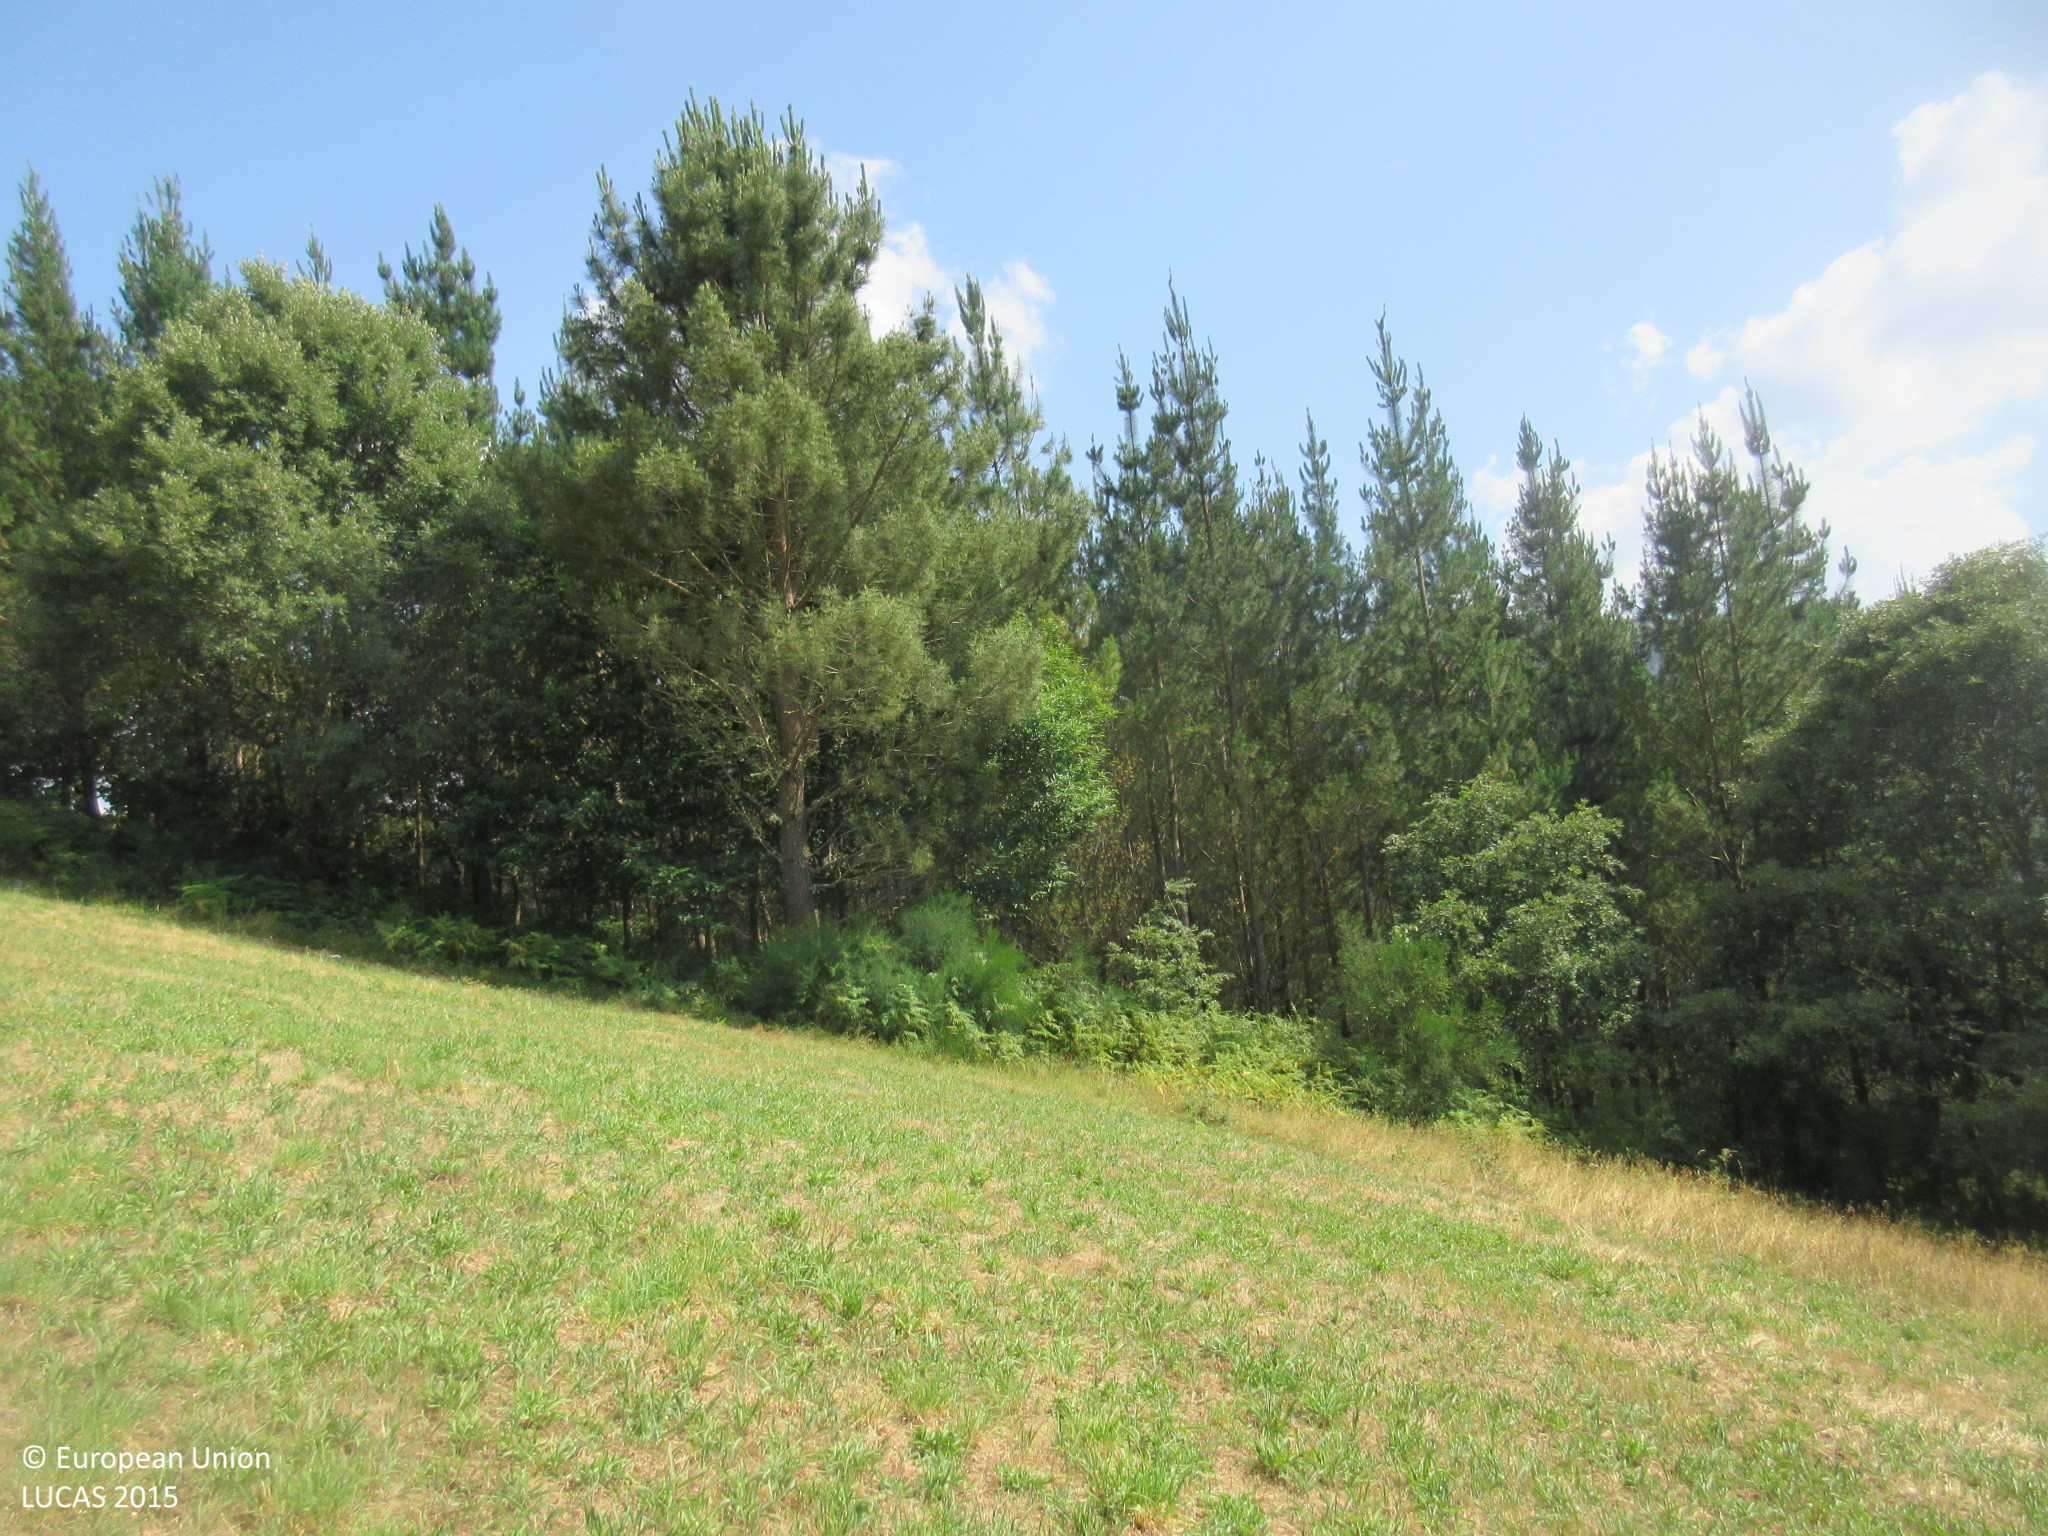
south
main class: Grassland
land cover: Grassland without tree/shrub cover
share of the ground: > 75 %
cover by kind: herbaceous plants 100 %
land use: Agriculture (excluding fallow land and kitchen gardens)
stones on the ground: 25 - 50 %
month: June
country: ES
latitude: 42.9729
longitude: -6.9946
